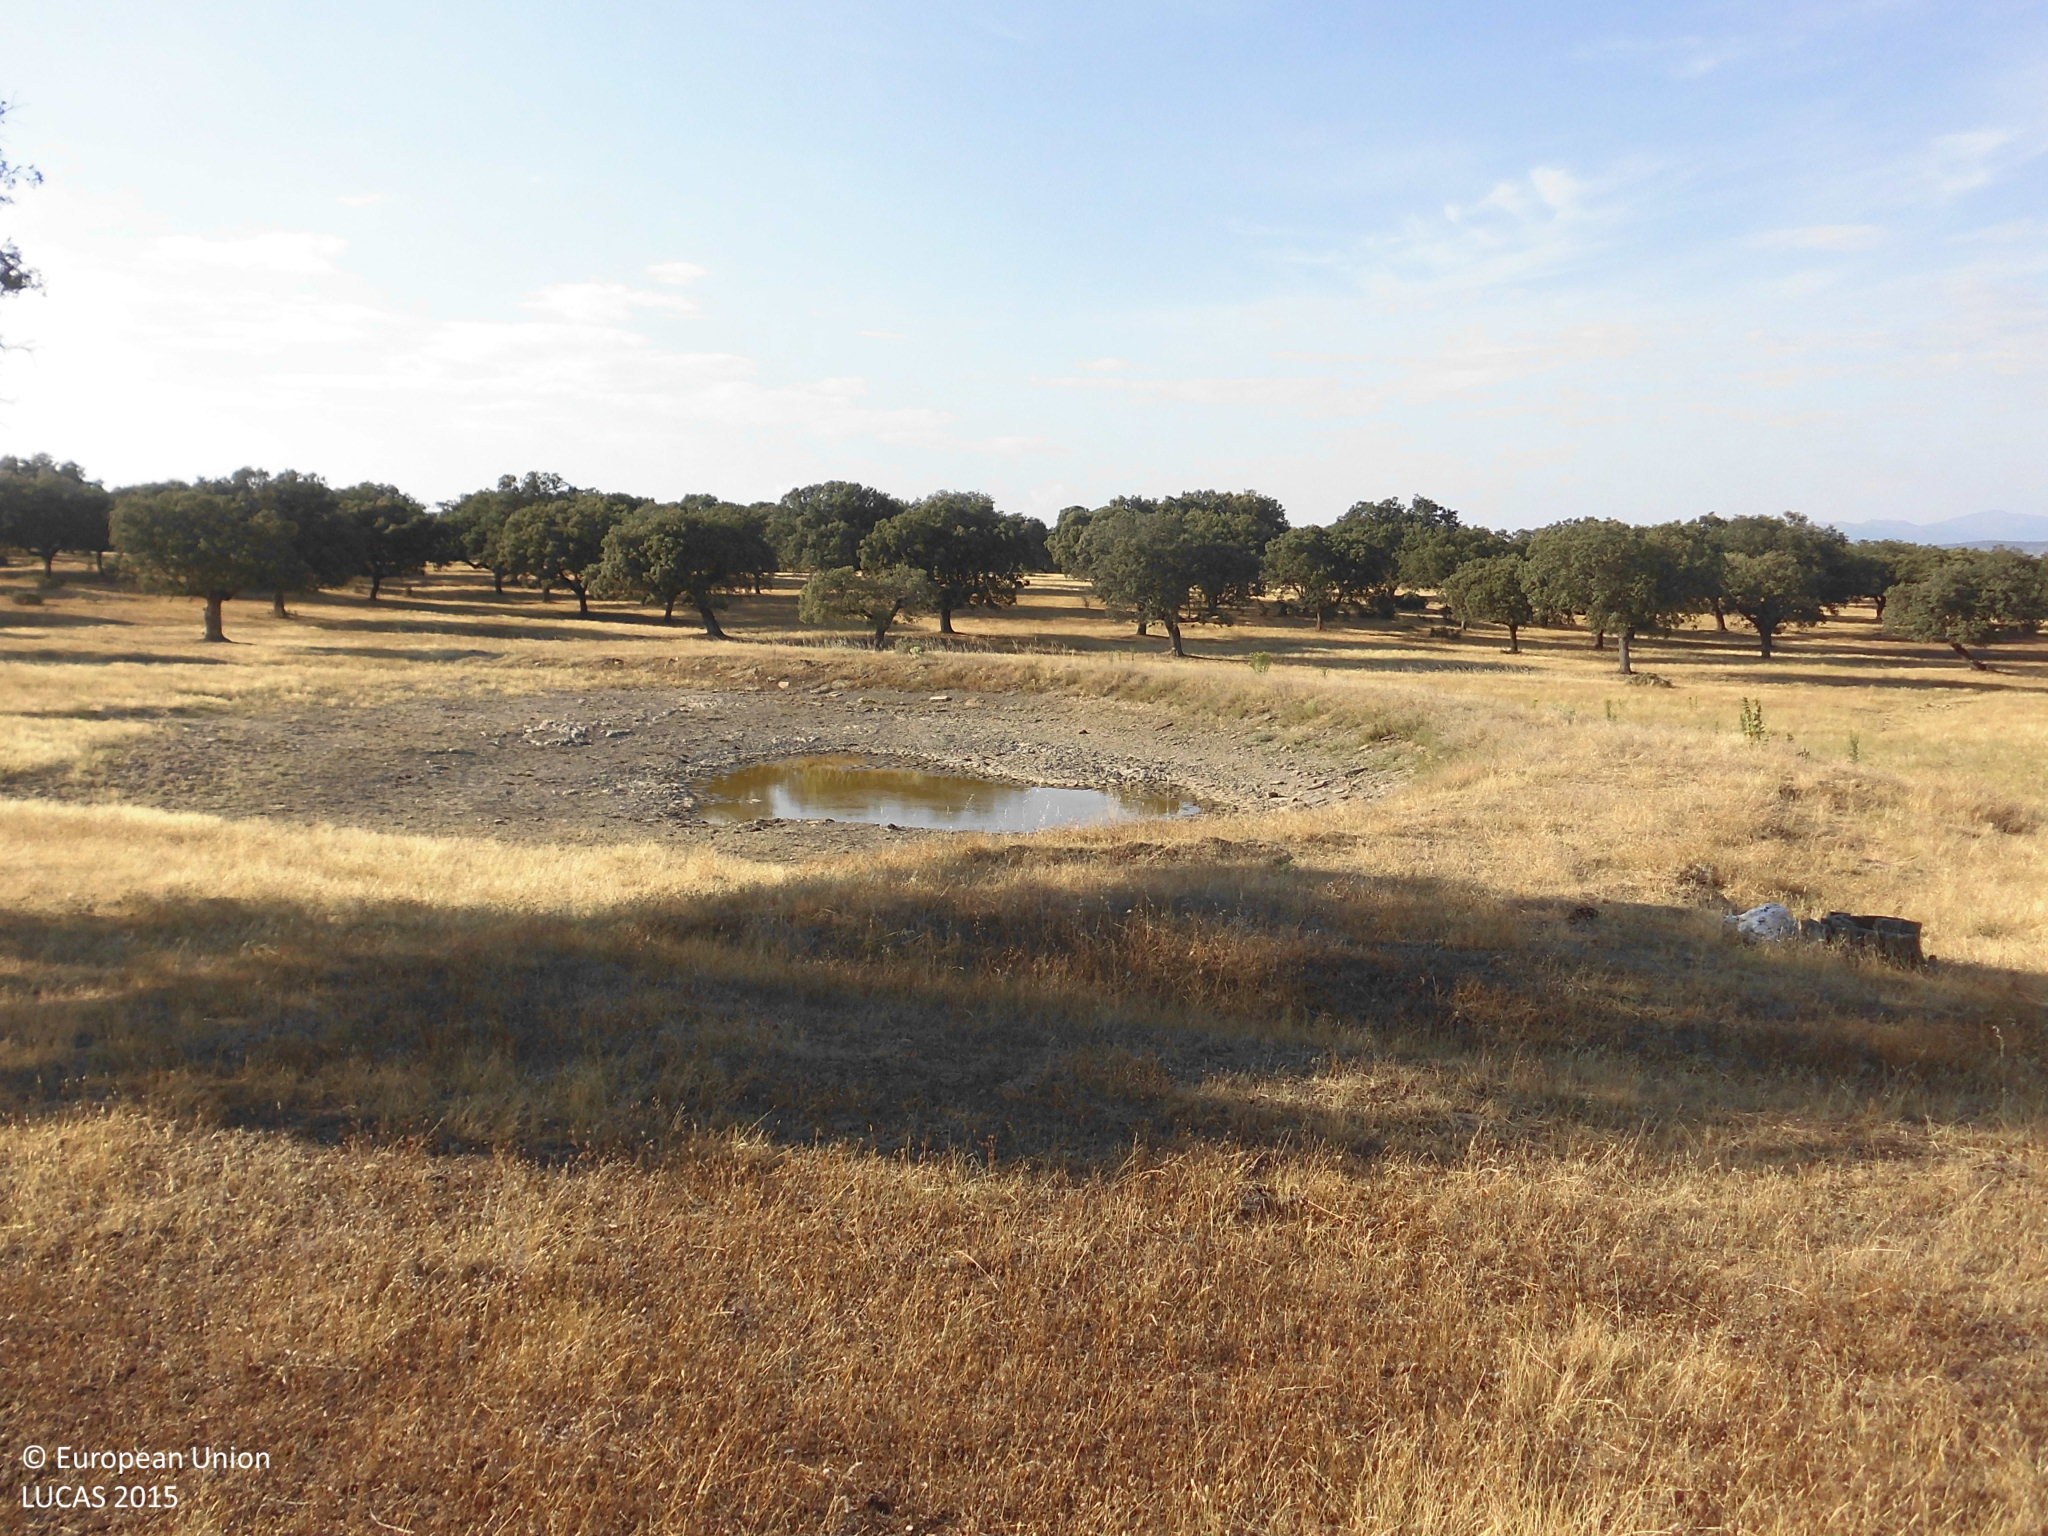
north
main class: Woodland
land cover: Broadleaved woodland
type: broadleaved evergreen forest
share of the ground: 25 - 50 %
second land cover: Grassland without tree/shrub cover
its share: > 75 %
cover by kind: herbaceous plants 75 %, broadleaved forest trees 25 %
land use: Forestry
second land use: Agriculture (excluding fallow land and kitchen gardens)
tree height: > 5 m
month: June
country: ES
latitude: 39.9161
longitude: -6.1332
